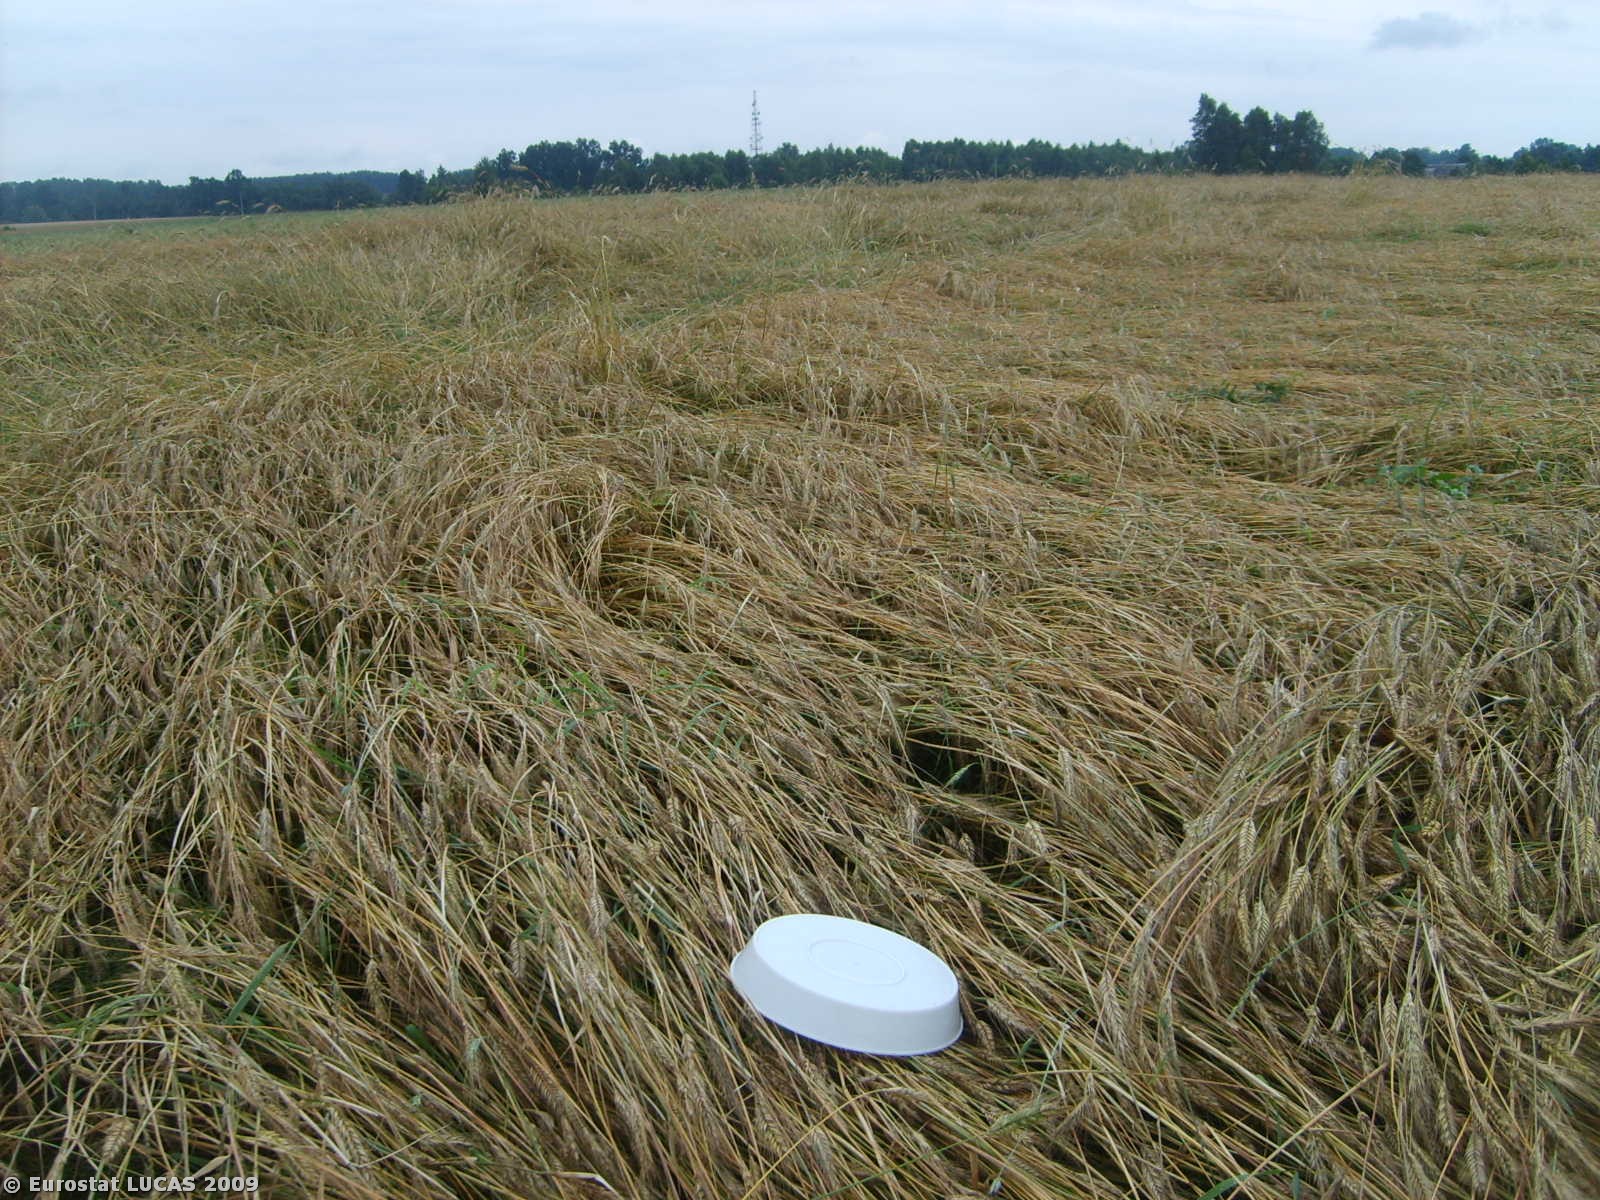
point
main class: Cropland
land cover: Rye
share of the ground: > 75 %
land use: Agriculture (excluding fallow land and kitchen gardens)
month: July
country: PL
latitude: 52.2893
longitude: 21.6795
